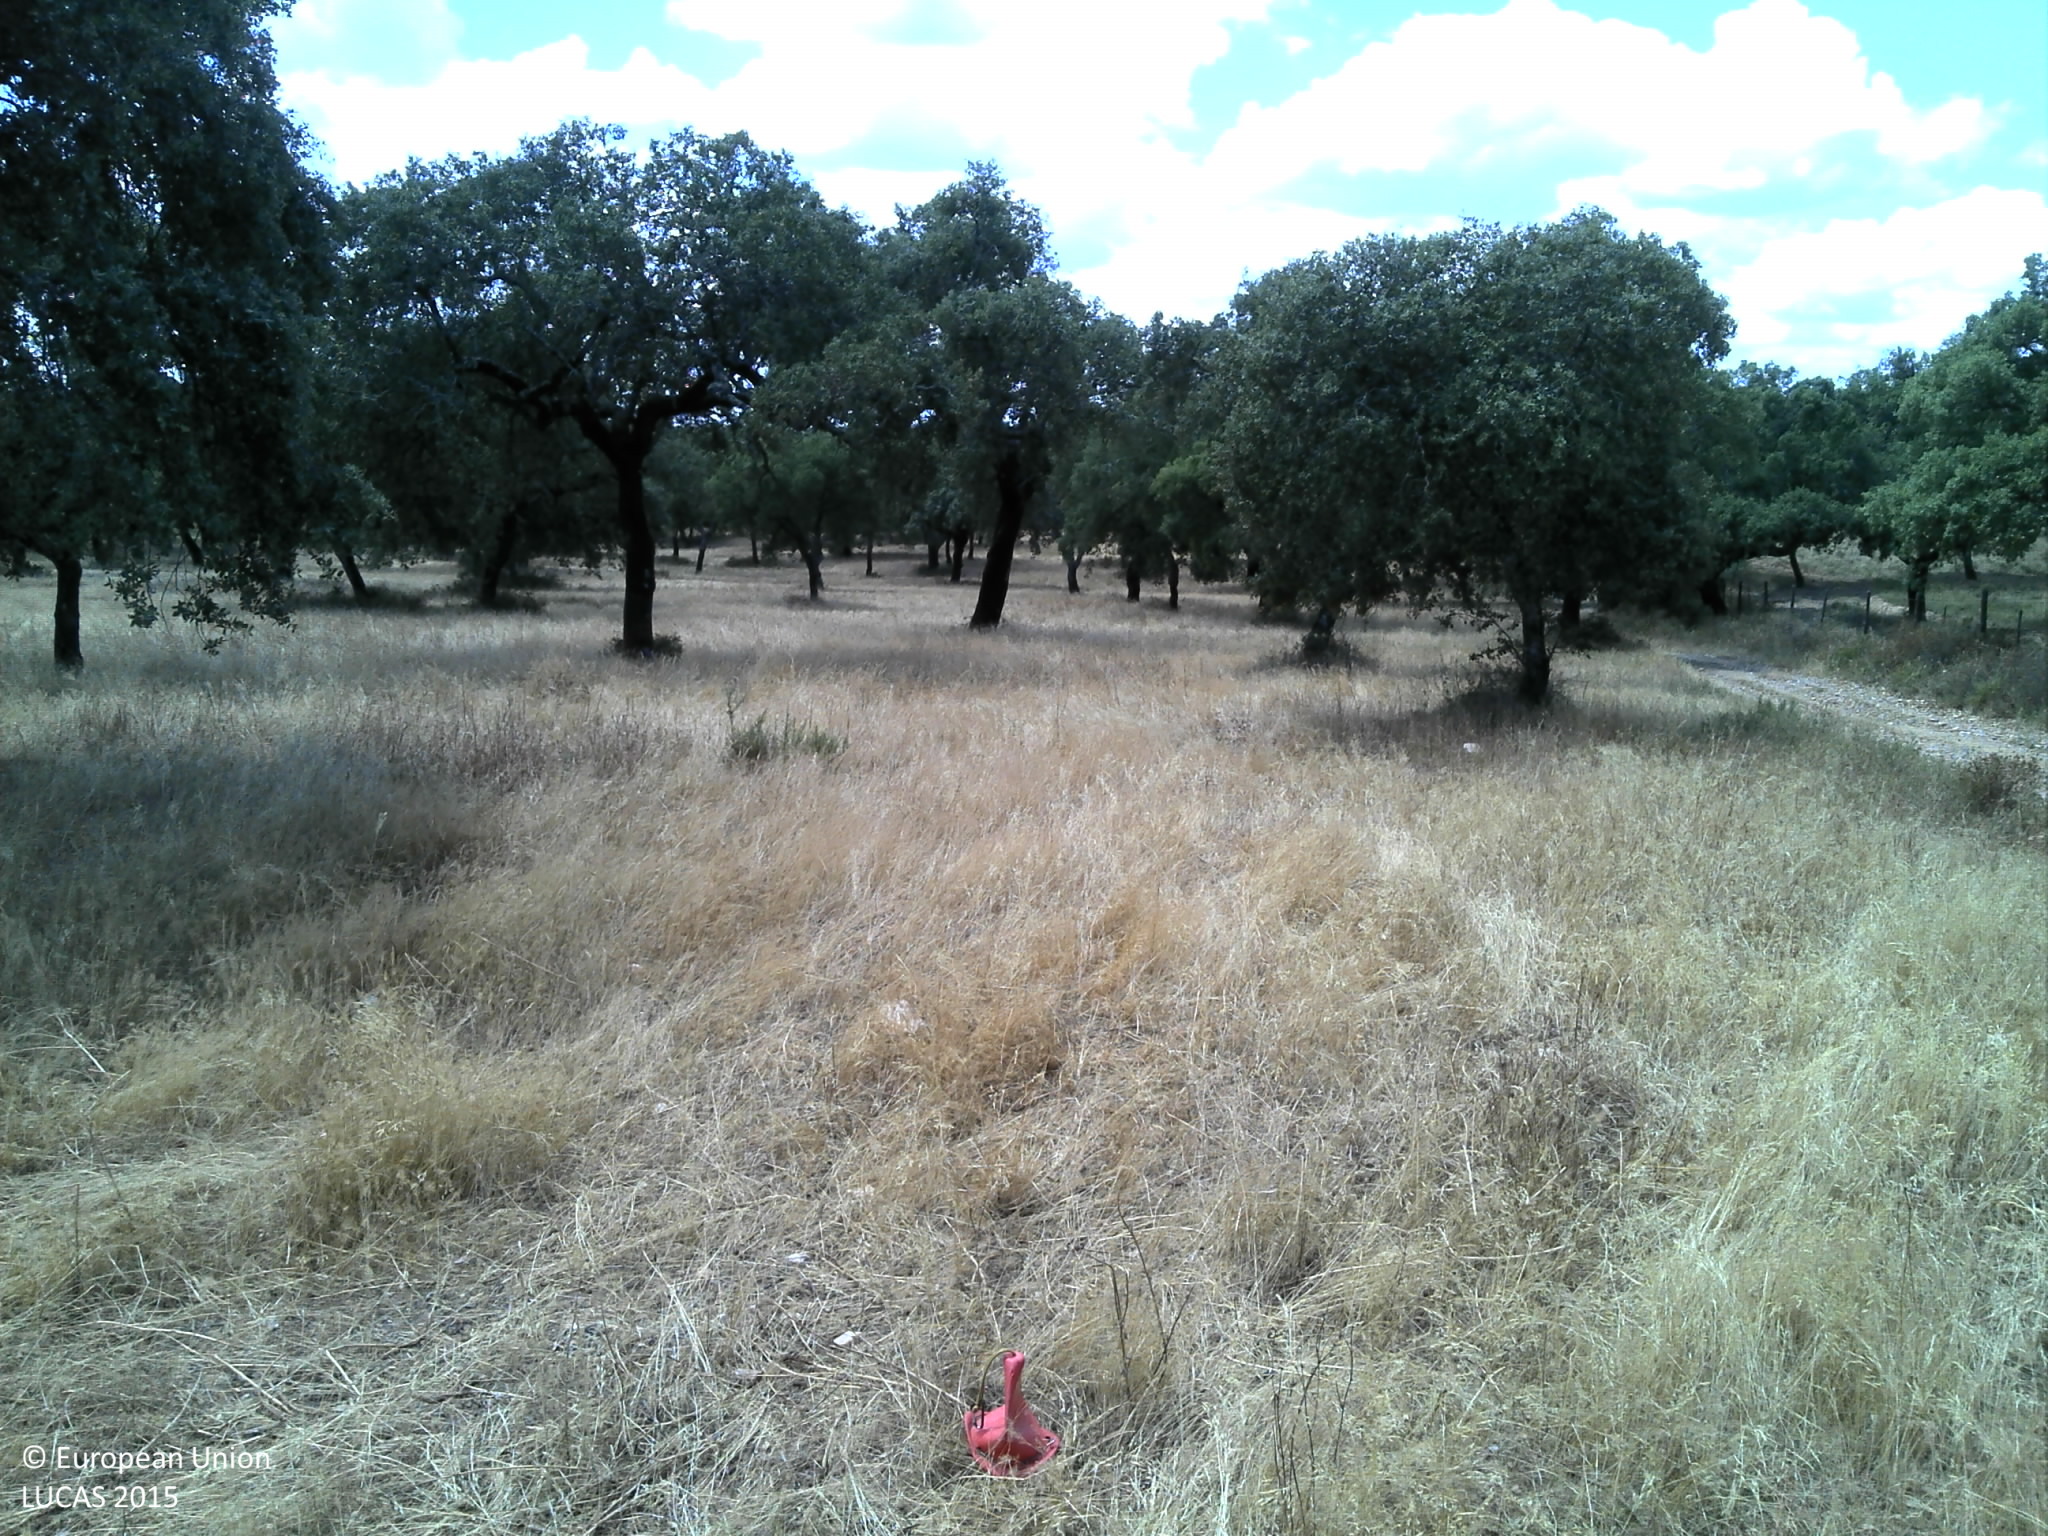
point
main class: Woodland
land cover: Broadleaved woodland
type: broadleaved evergreen forest
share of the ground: 25 - 50 %
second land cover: Grassland without tree/shrub cover
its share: 10 - 25 %
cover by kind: unconsolidated bare surface 55 %, broadleaved forest trees 30 %, herbaceous plants 15 %
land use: Forestry
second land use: Agriculture (excluding fallow land and kitchen gardens)
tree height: > 5 m
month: June
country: PT
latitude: 38.4980
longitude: -8.0784
